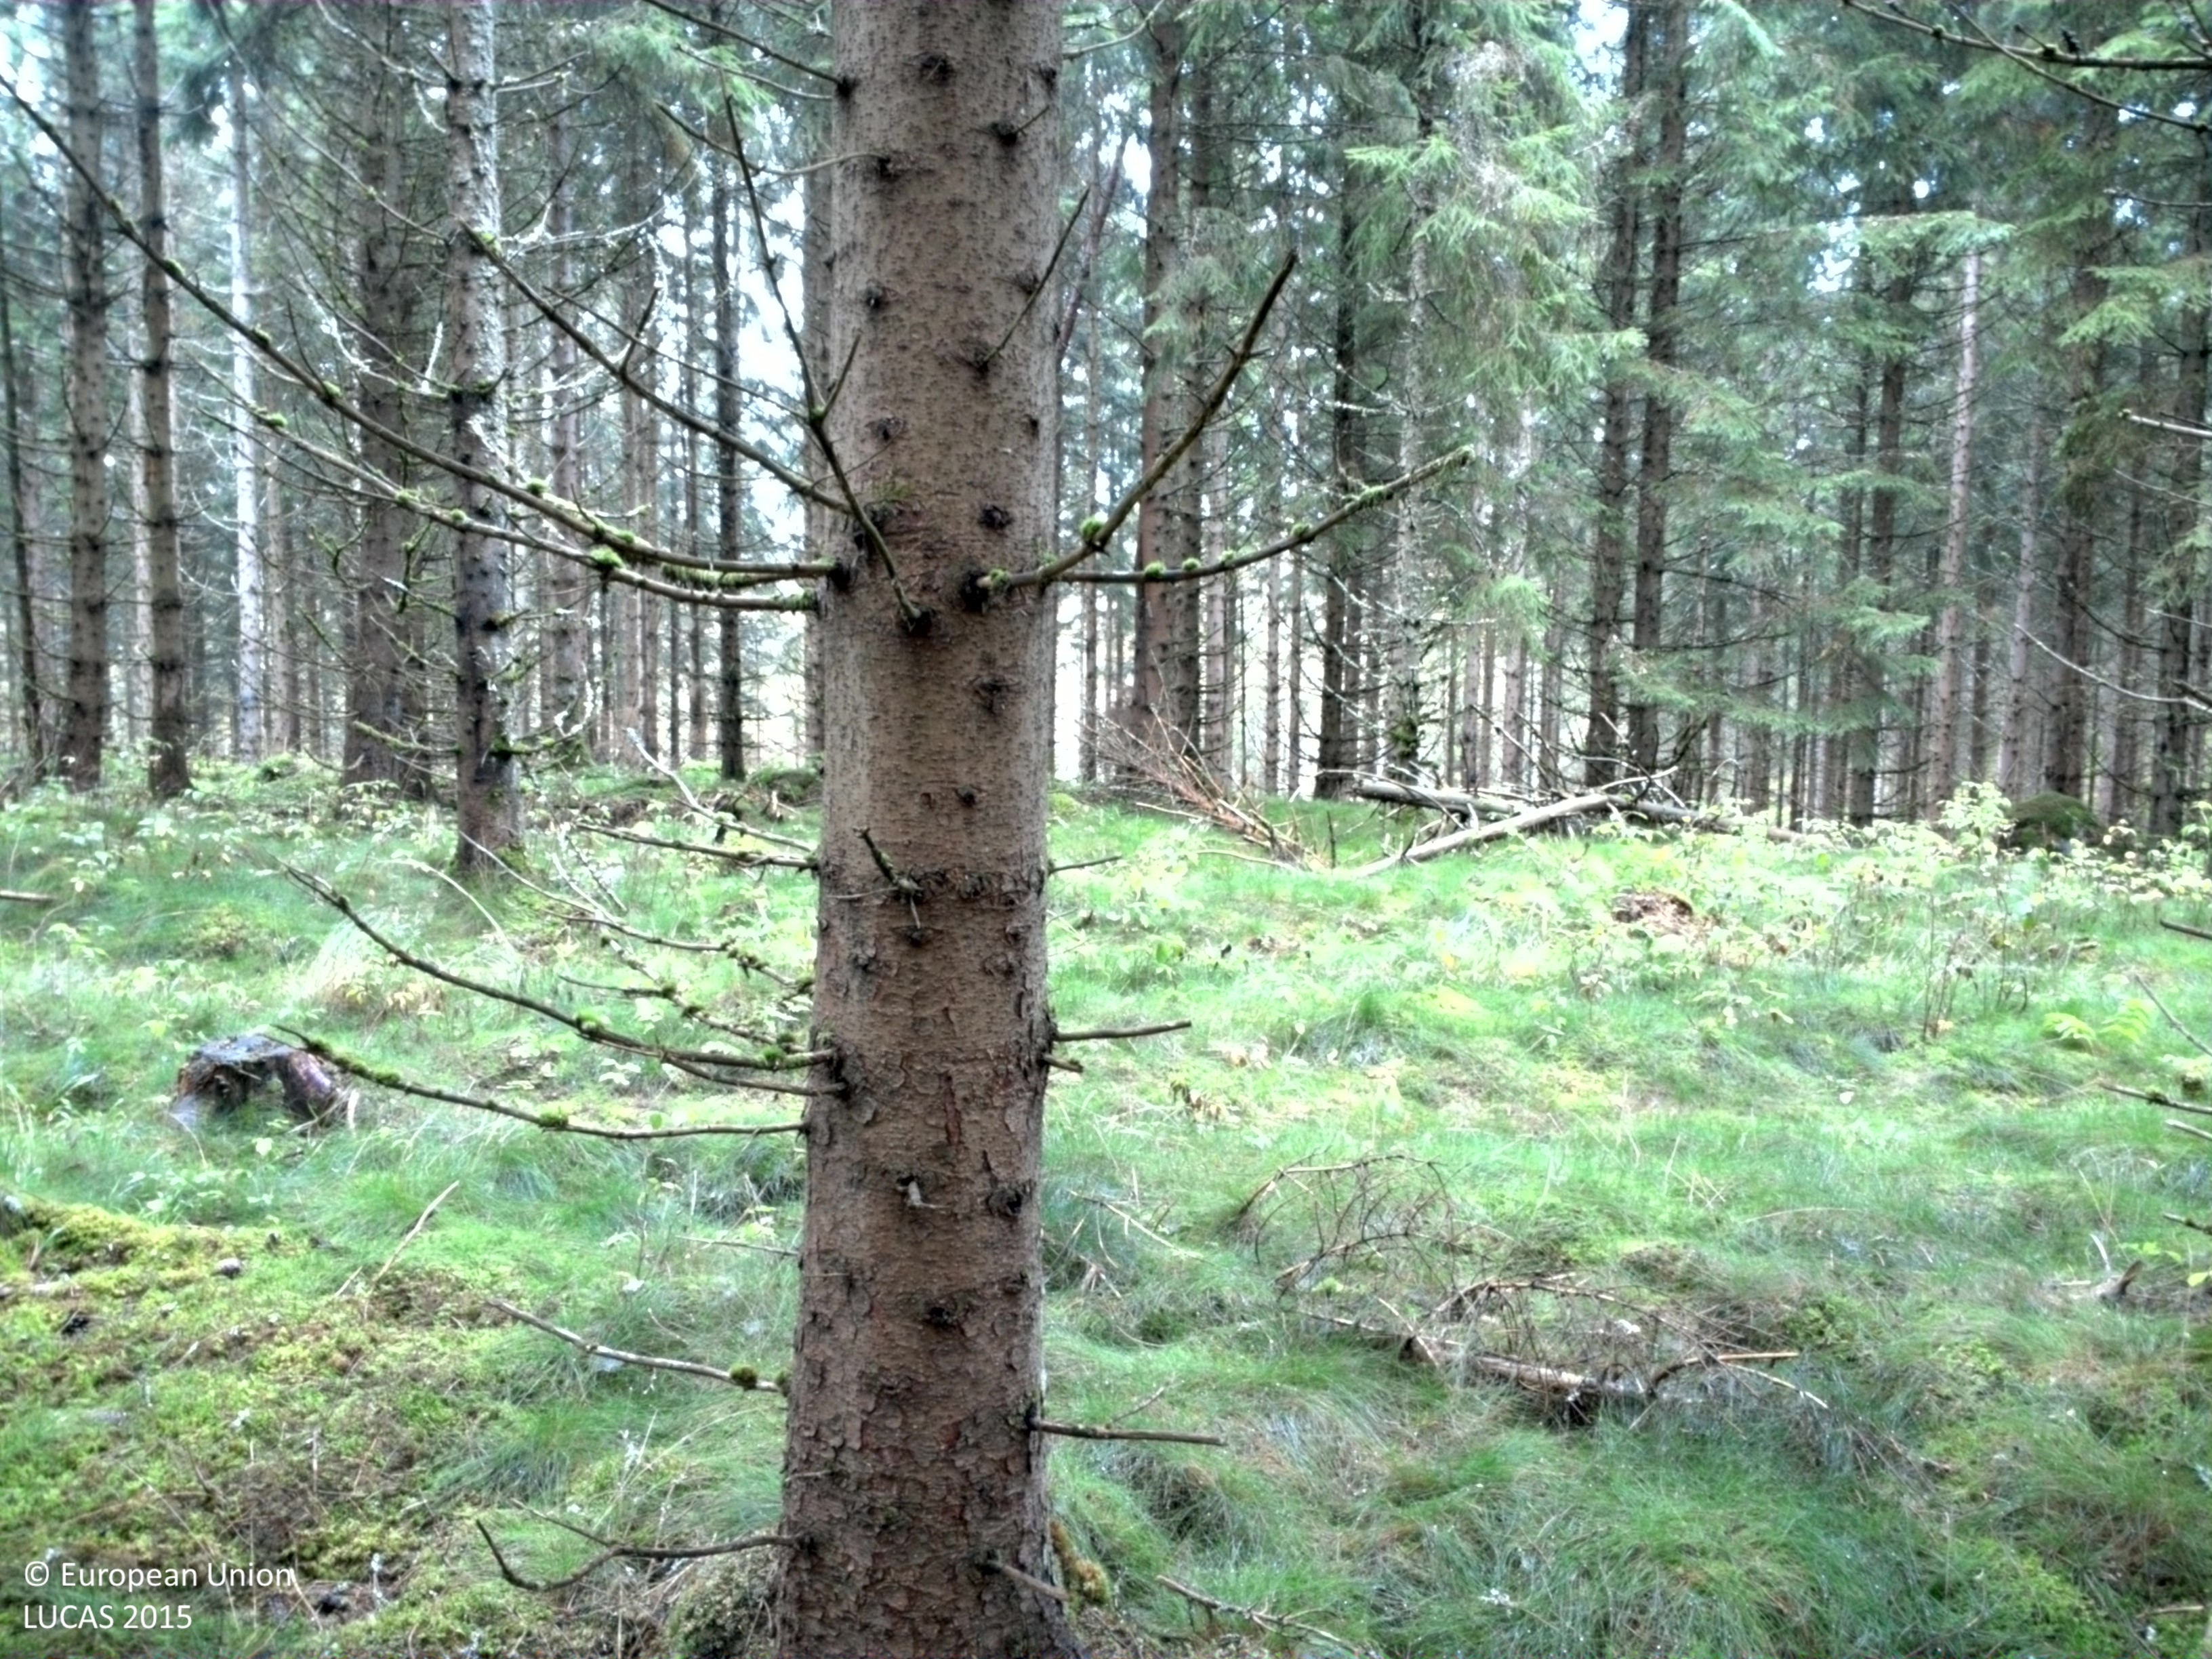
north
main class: Woodland
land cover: Spruce dominated coniferous woodland
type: boreal forest
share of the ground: 50 - 75 %
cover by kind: coniferous forest trees 60 %, lichens and mosses 30 %, herbaceous plants 10 %
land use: Forestry
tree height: > 5 m
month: September
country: SE
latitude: 58.1289
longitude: 13.1362
